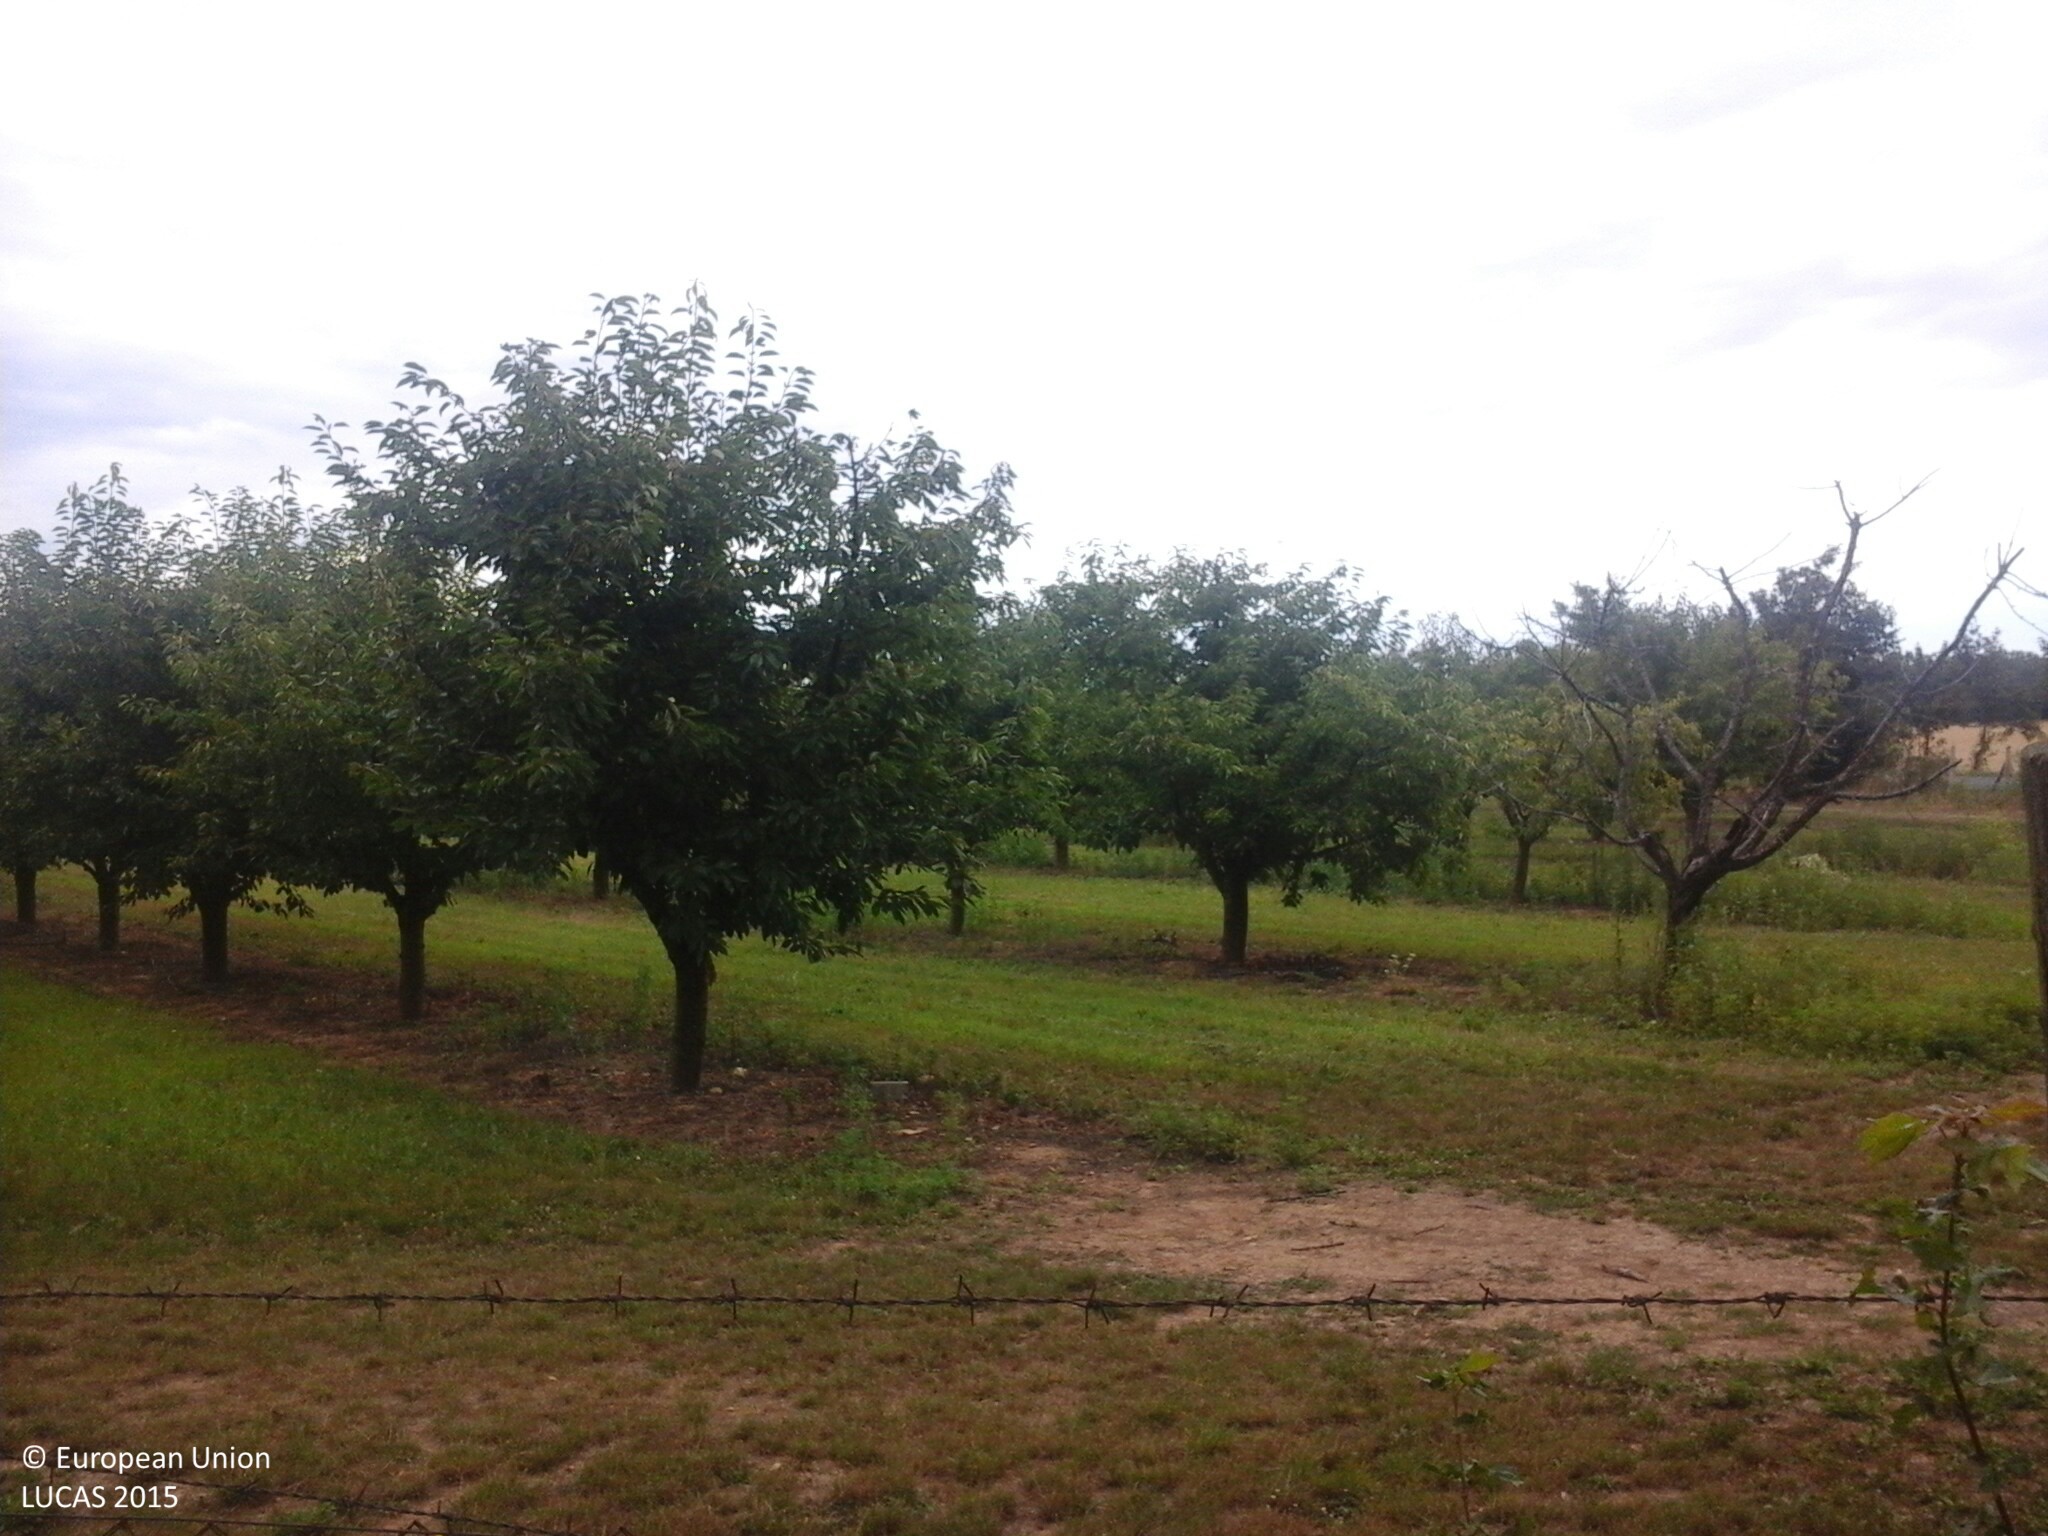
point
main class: Cropland
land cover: Cherry fruit
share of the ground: 50 - 75 %
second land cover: Grassland without tree/shrub cover
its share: 50 - 75 %
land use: Agriculture (excluding fallow land and kitchen gardens)
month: July
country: HU
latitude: 47.0522
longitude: 17.9204
